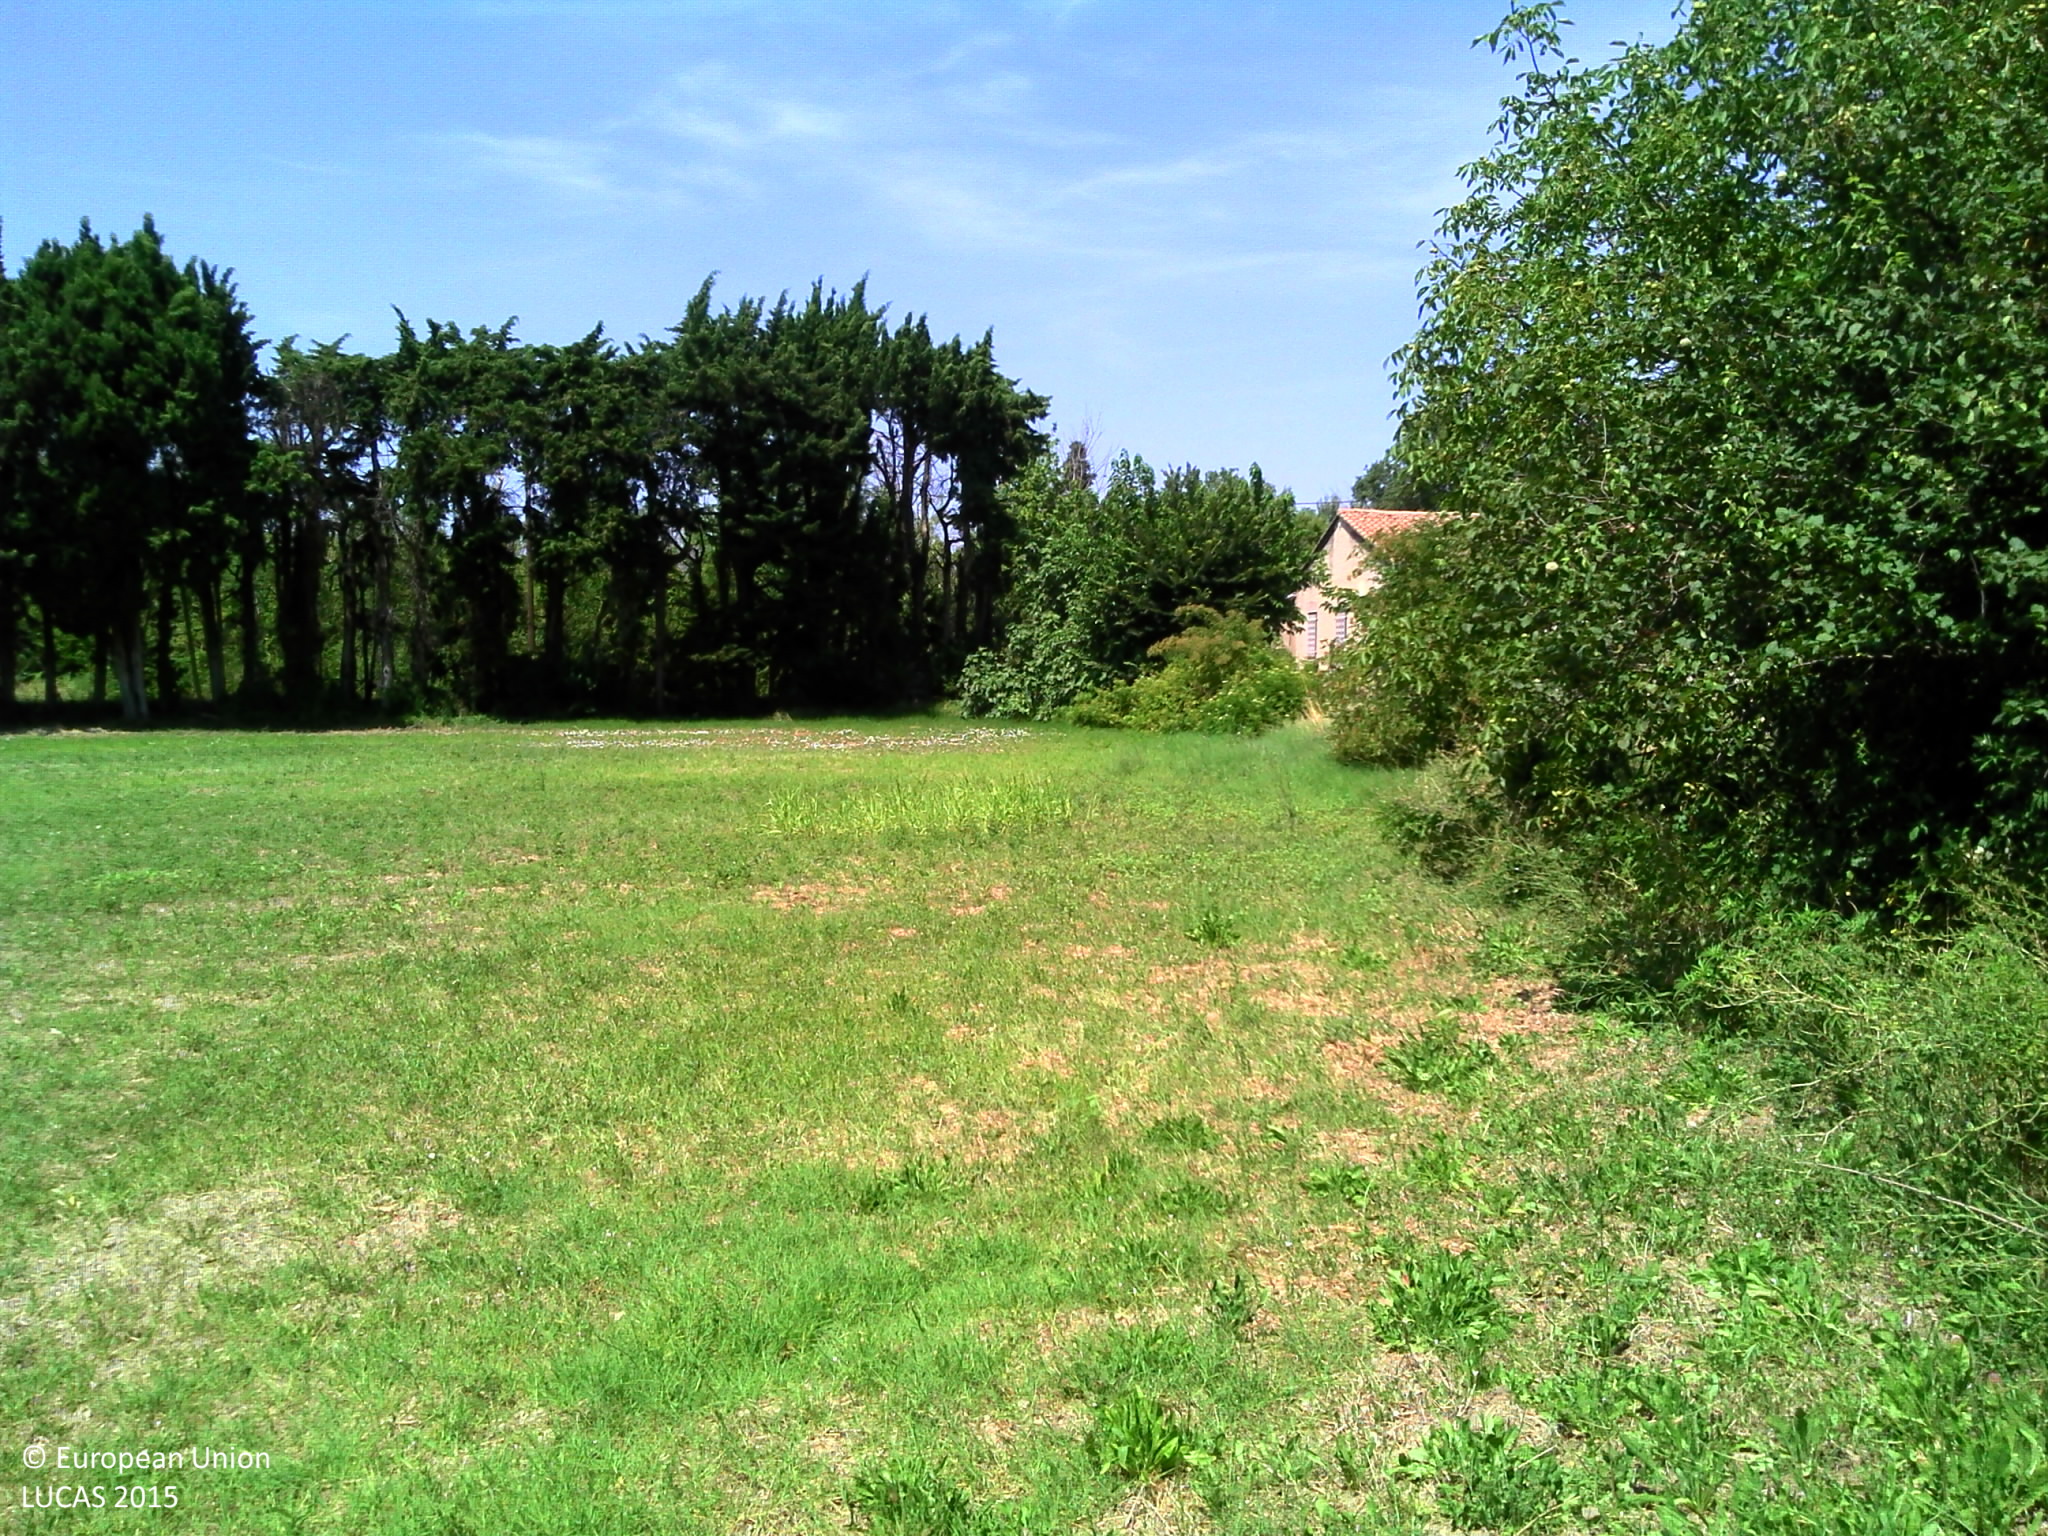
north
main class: Grassland
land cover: Grassland without tree/shrub cover
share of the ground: > 75 %
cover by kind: herbaceous plants 100 %
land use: Agriculture (excluding fallow land and kitchen gardens)
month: July
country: FR
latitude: 44.0507
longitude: 5.0282
